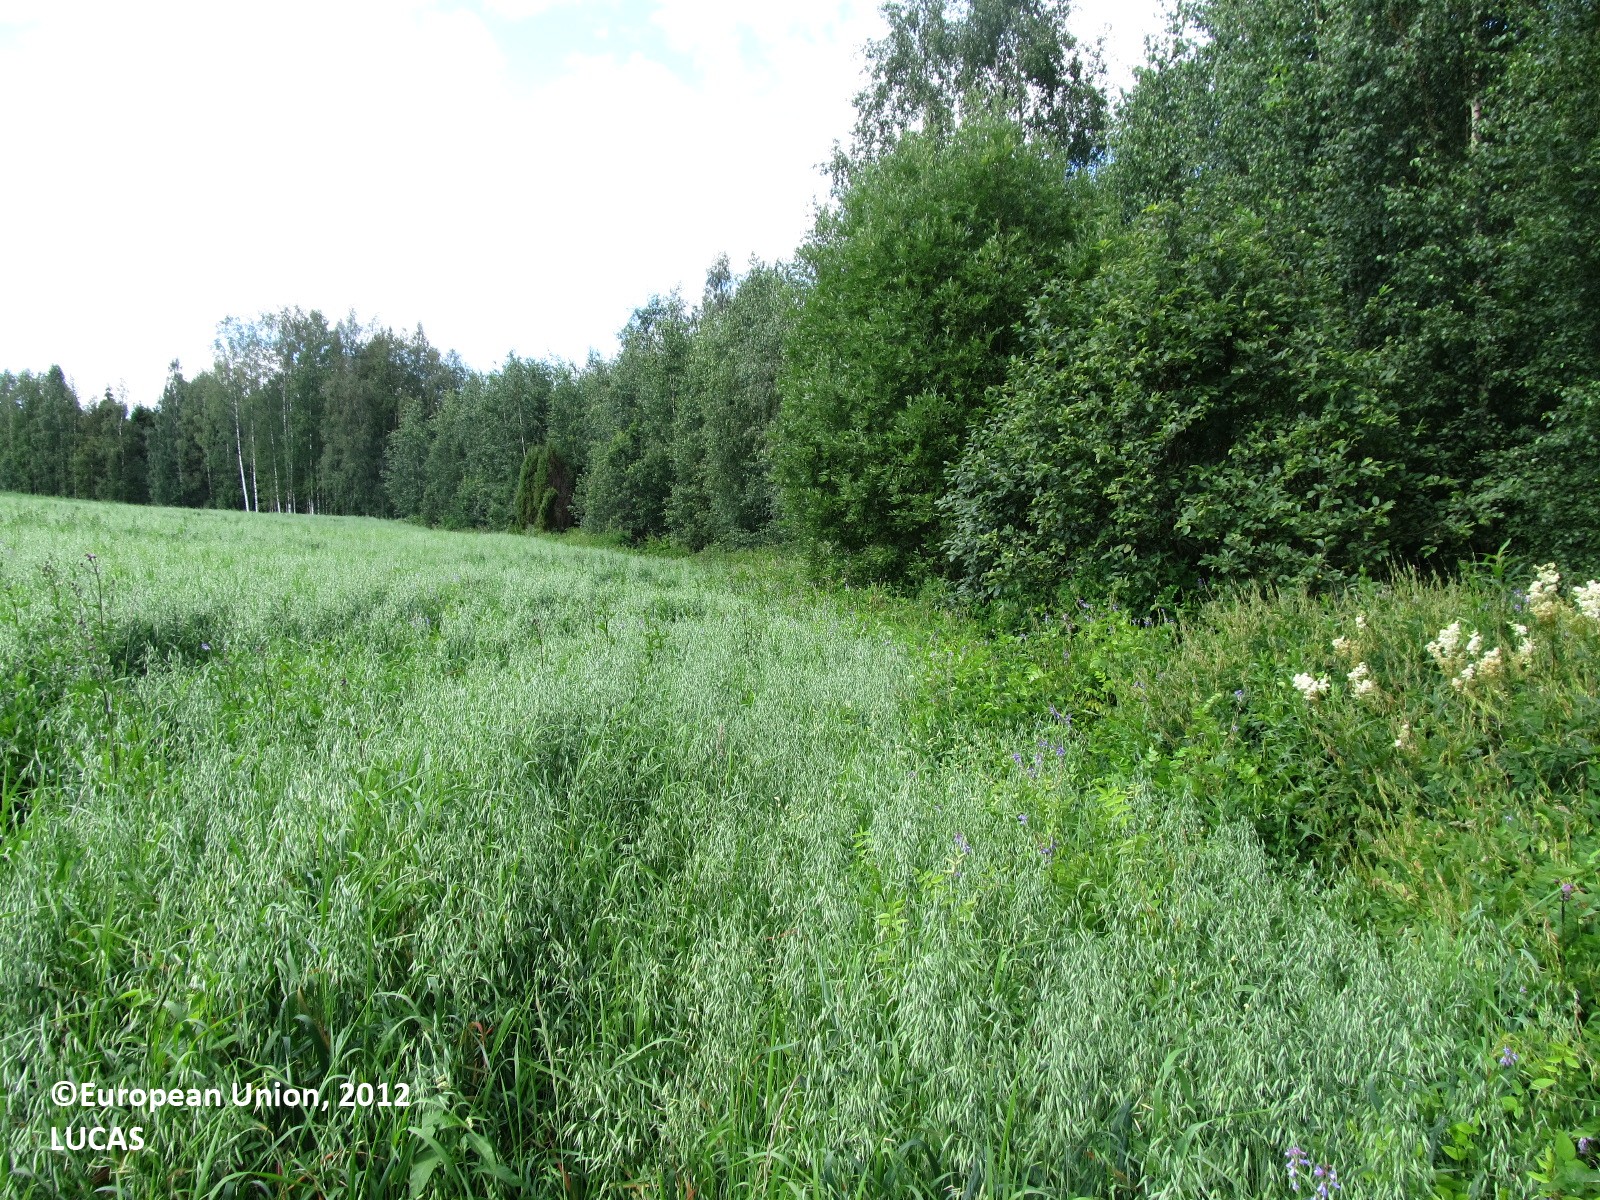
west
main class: Cropland
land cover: Oats
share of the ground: 50 - 75 %
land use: Agriculture (excluding fallow land and kitchen gardens)
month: July
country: FI
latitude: 61.9734
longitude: 28.6209
